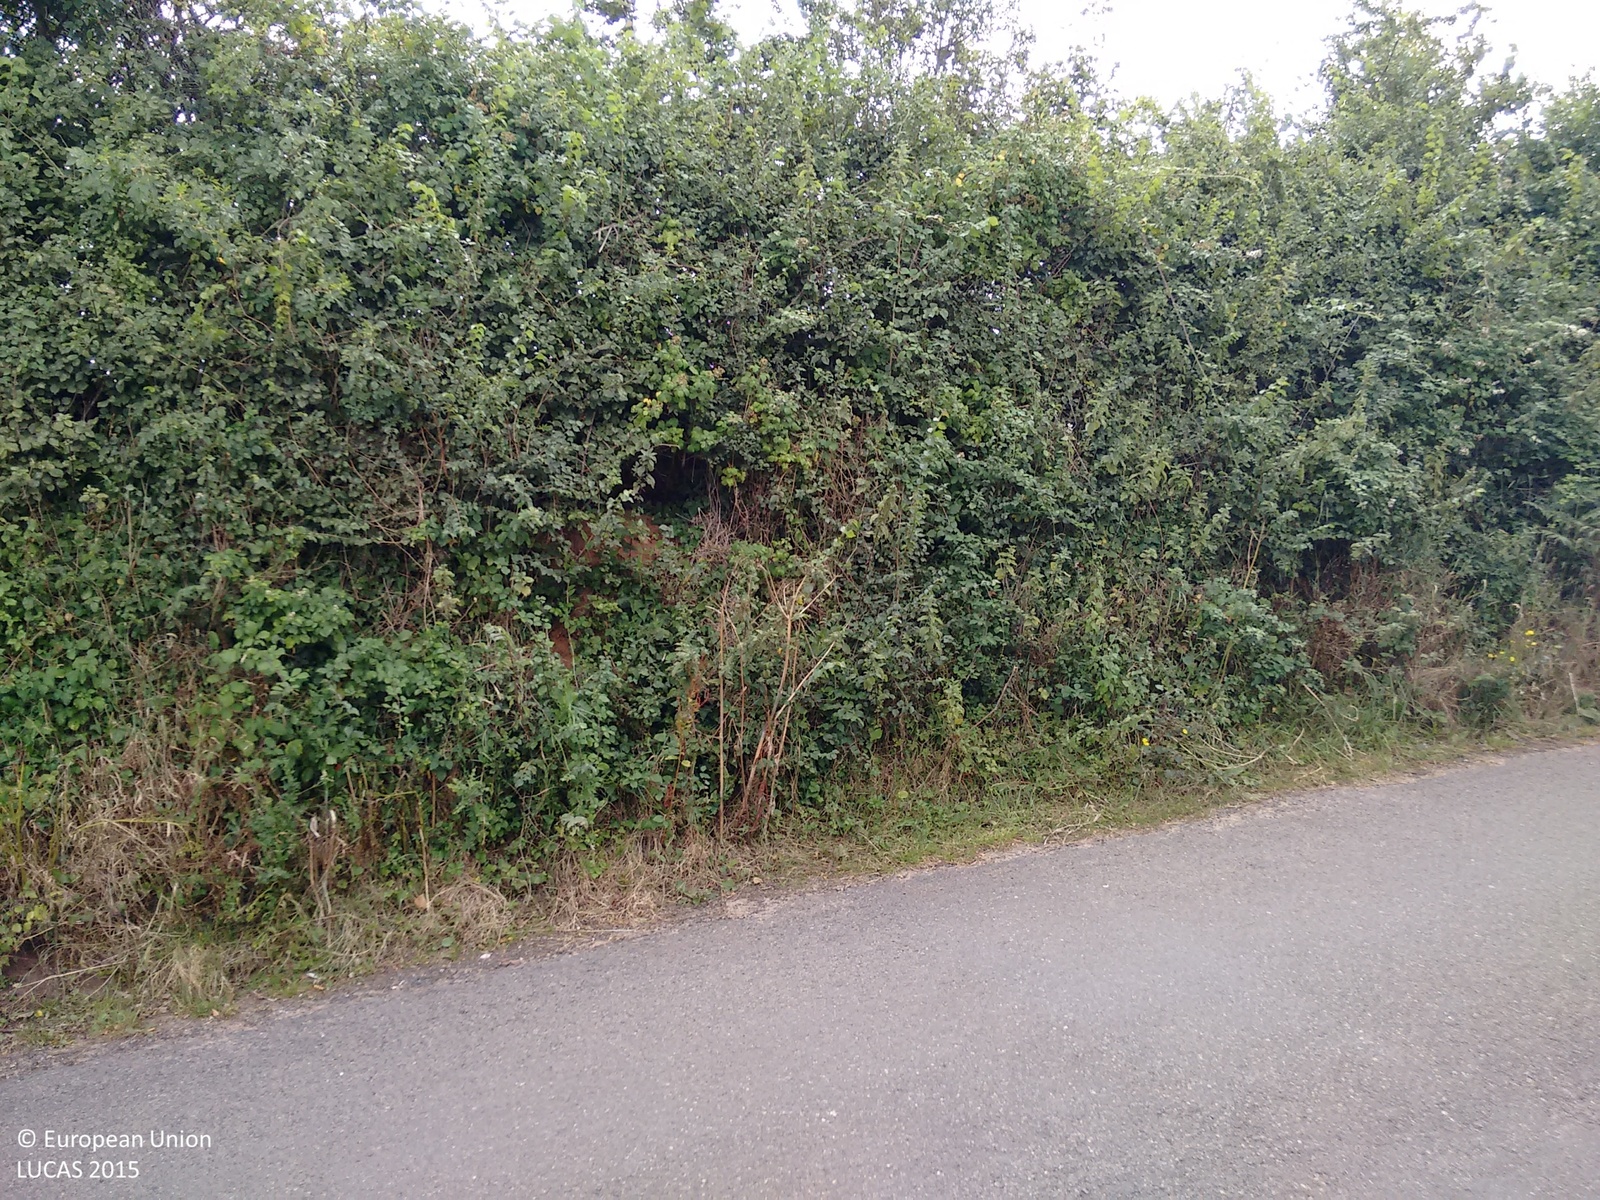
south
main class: Cropland
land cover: Rape and turnip rape
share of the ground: 10 - 25 %
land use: Agriculture (excluding fallow land and kitchen gardens)
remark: Harvested field
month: August
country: GB
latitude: 50.6028
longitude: -3.4634
